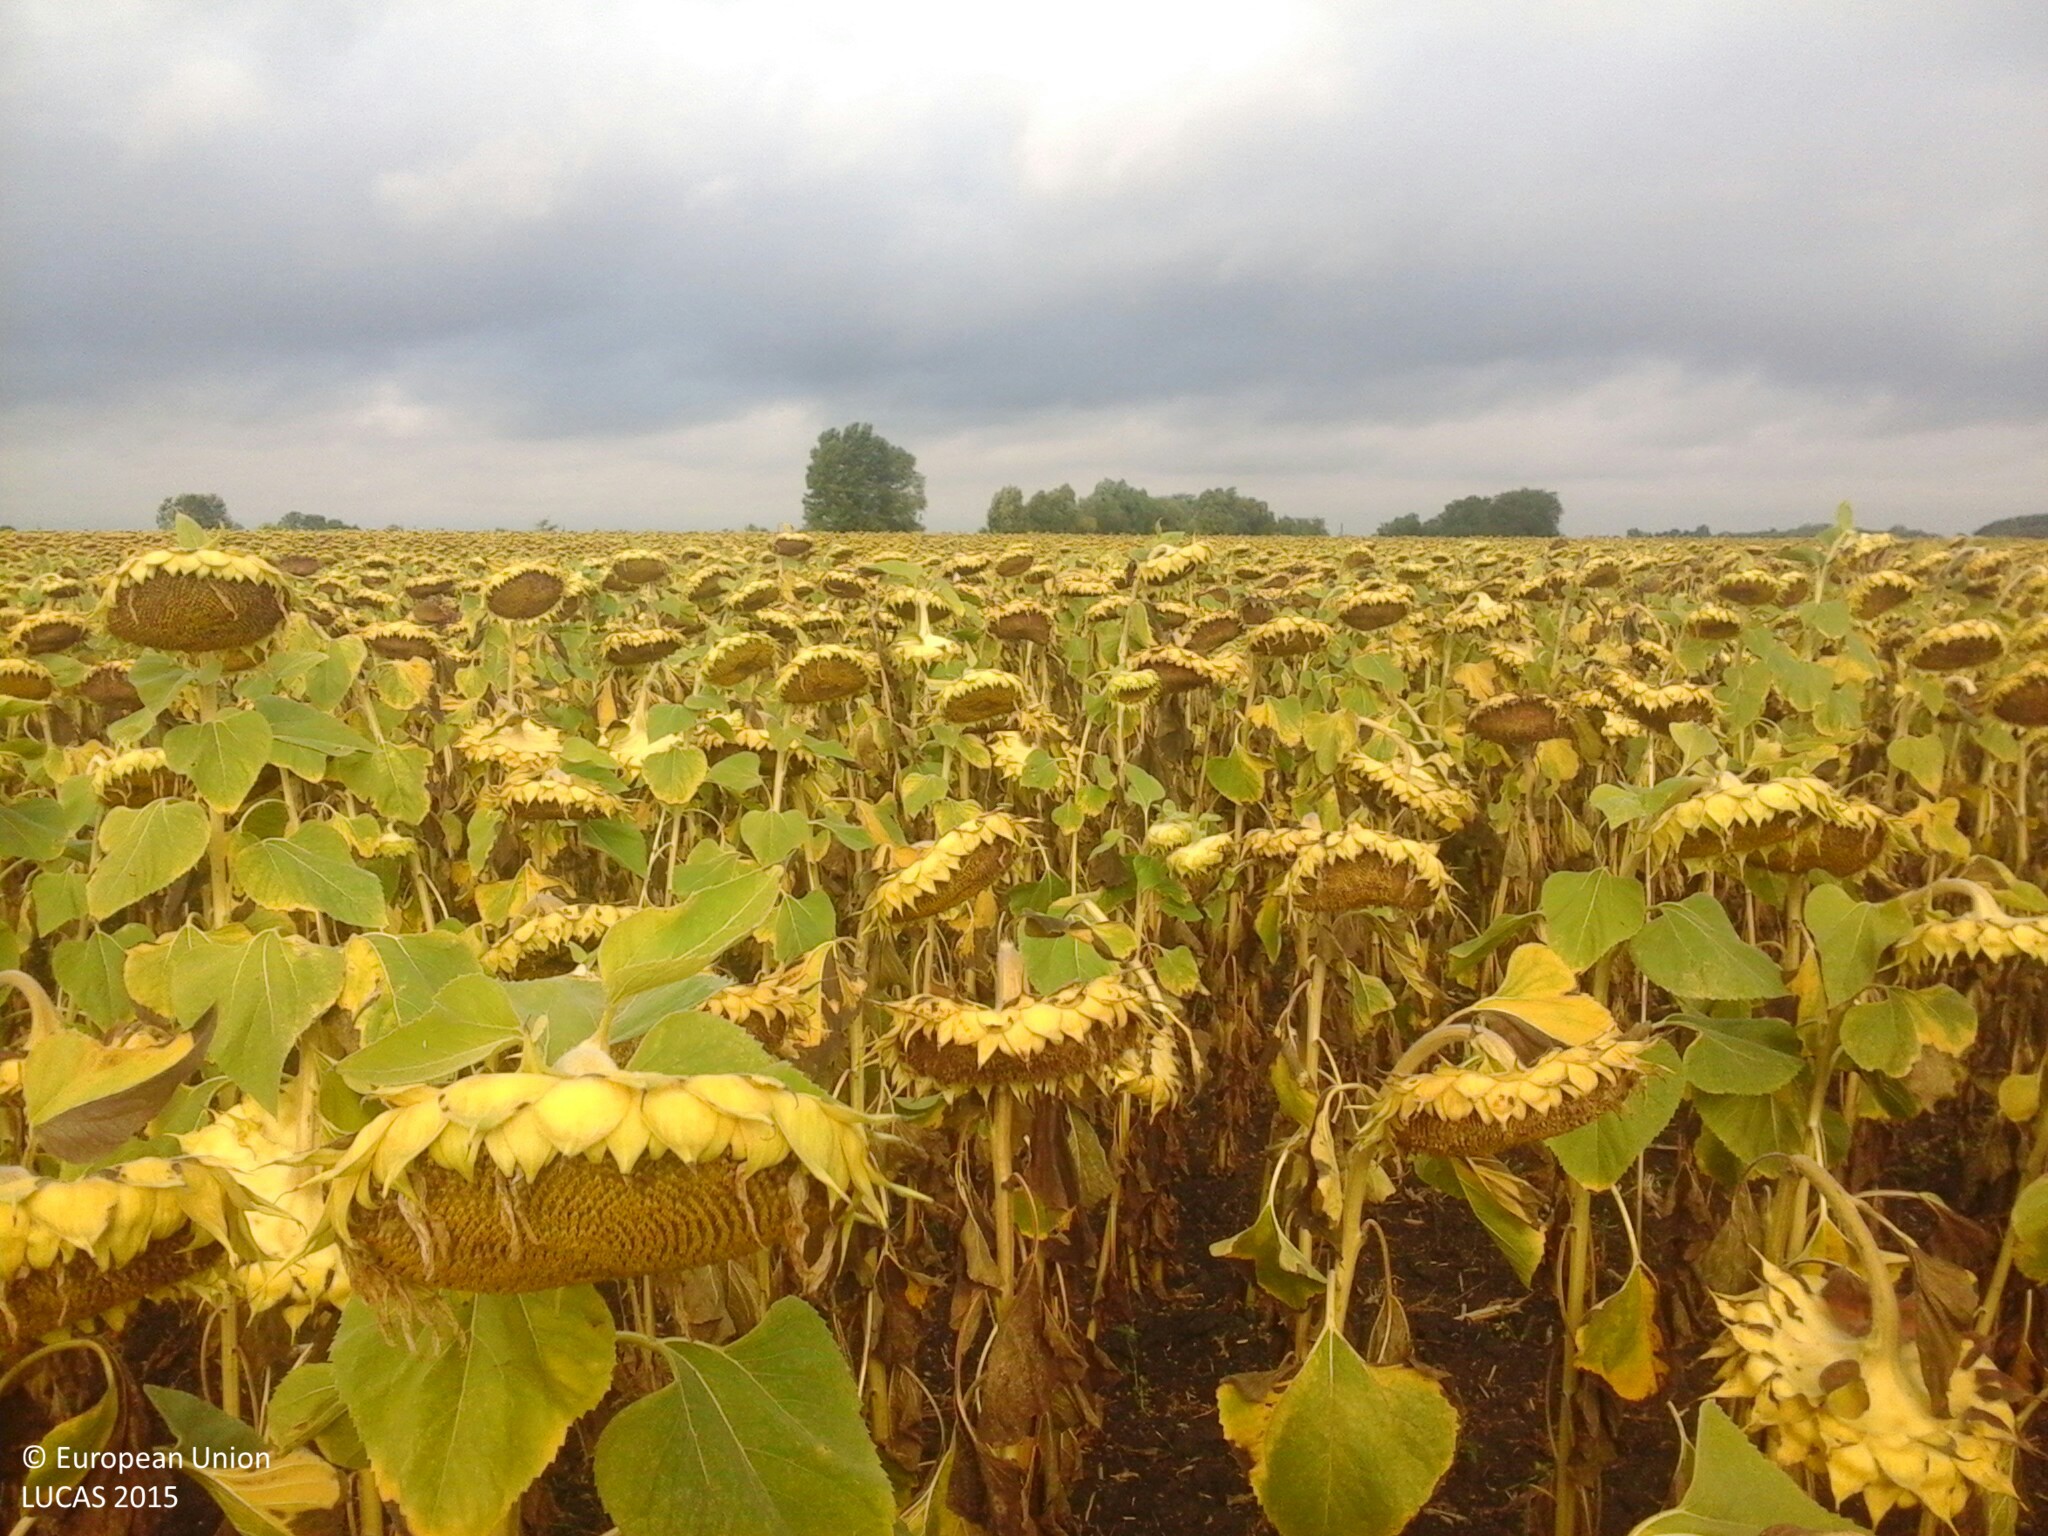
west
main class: Cropland
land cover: Sunflower
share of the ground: > 75 %
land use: Agriculture (excluding fallow land and kitchen gardens)
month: August
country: HU
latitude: 47.0618
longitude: 21.6153
